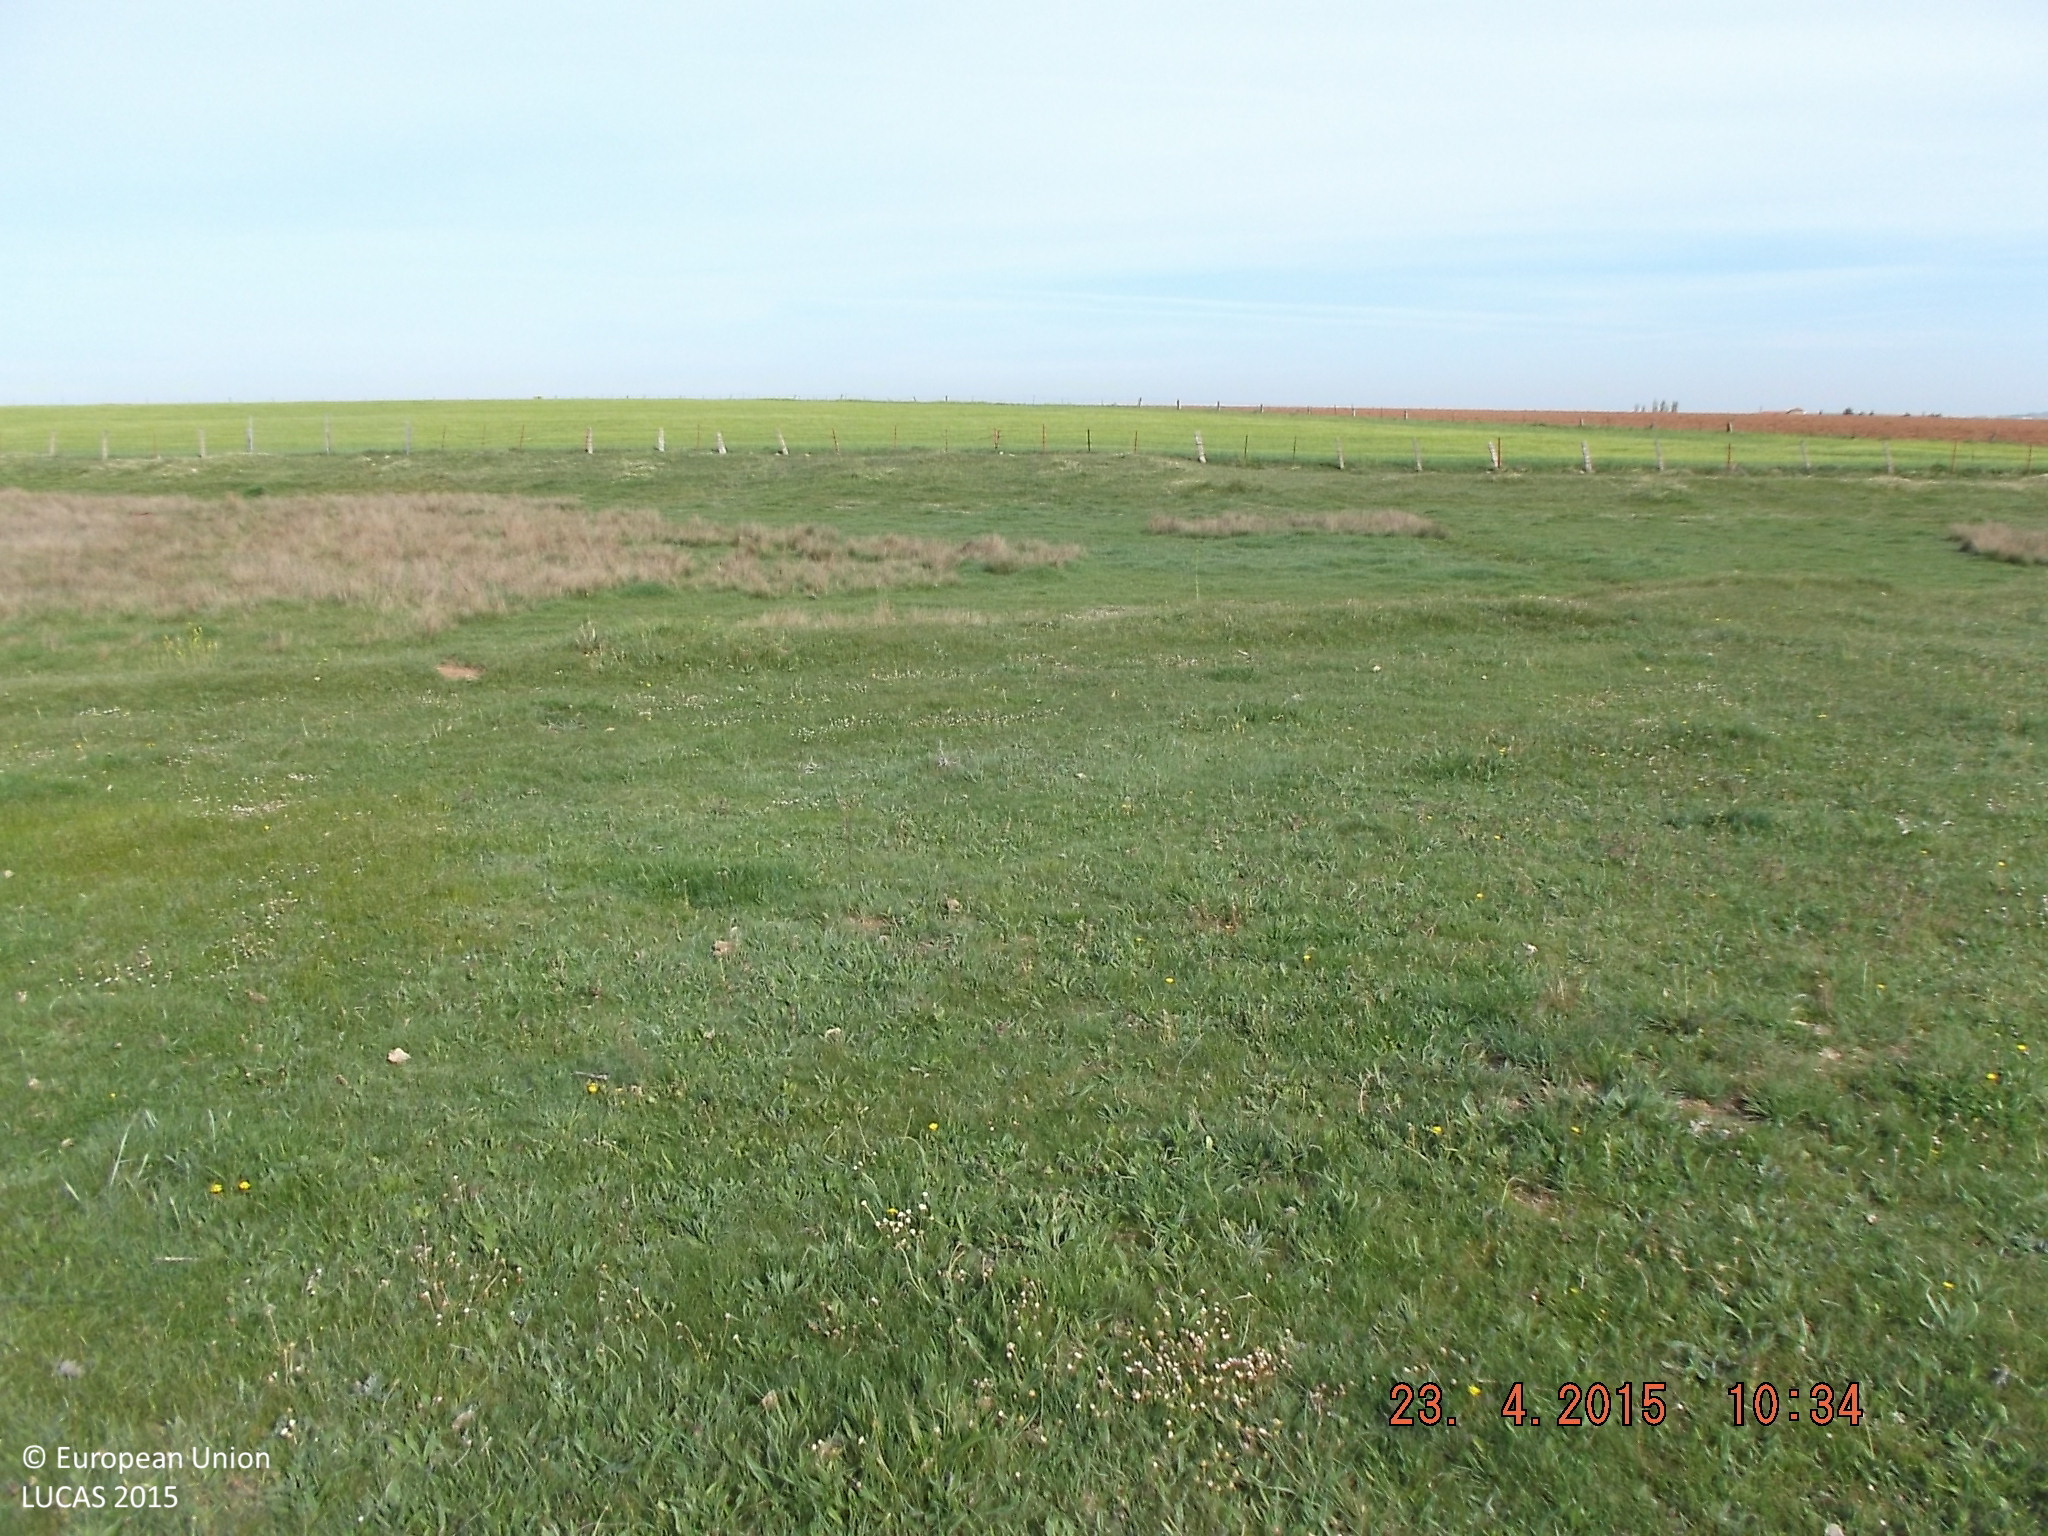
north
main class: Grassland
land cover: Grassland without tree/shrub cover
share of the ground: > 75 %
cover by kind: herbaceous plants 100 %
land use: Agriculture (excluding fallow land and kitchen gardens)
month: April
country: ES
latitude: 40.9450
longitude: -5.9162
